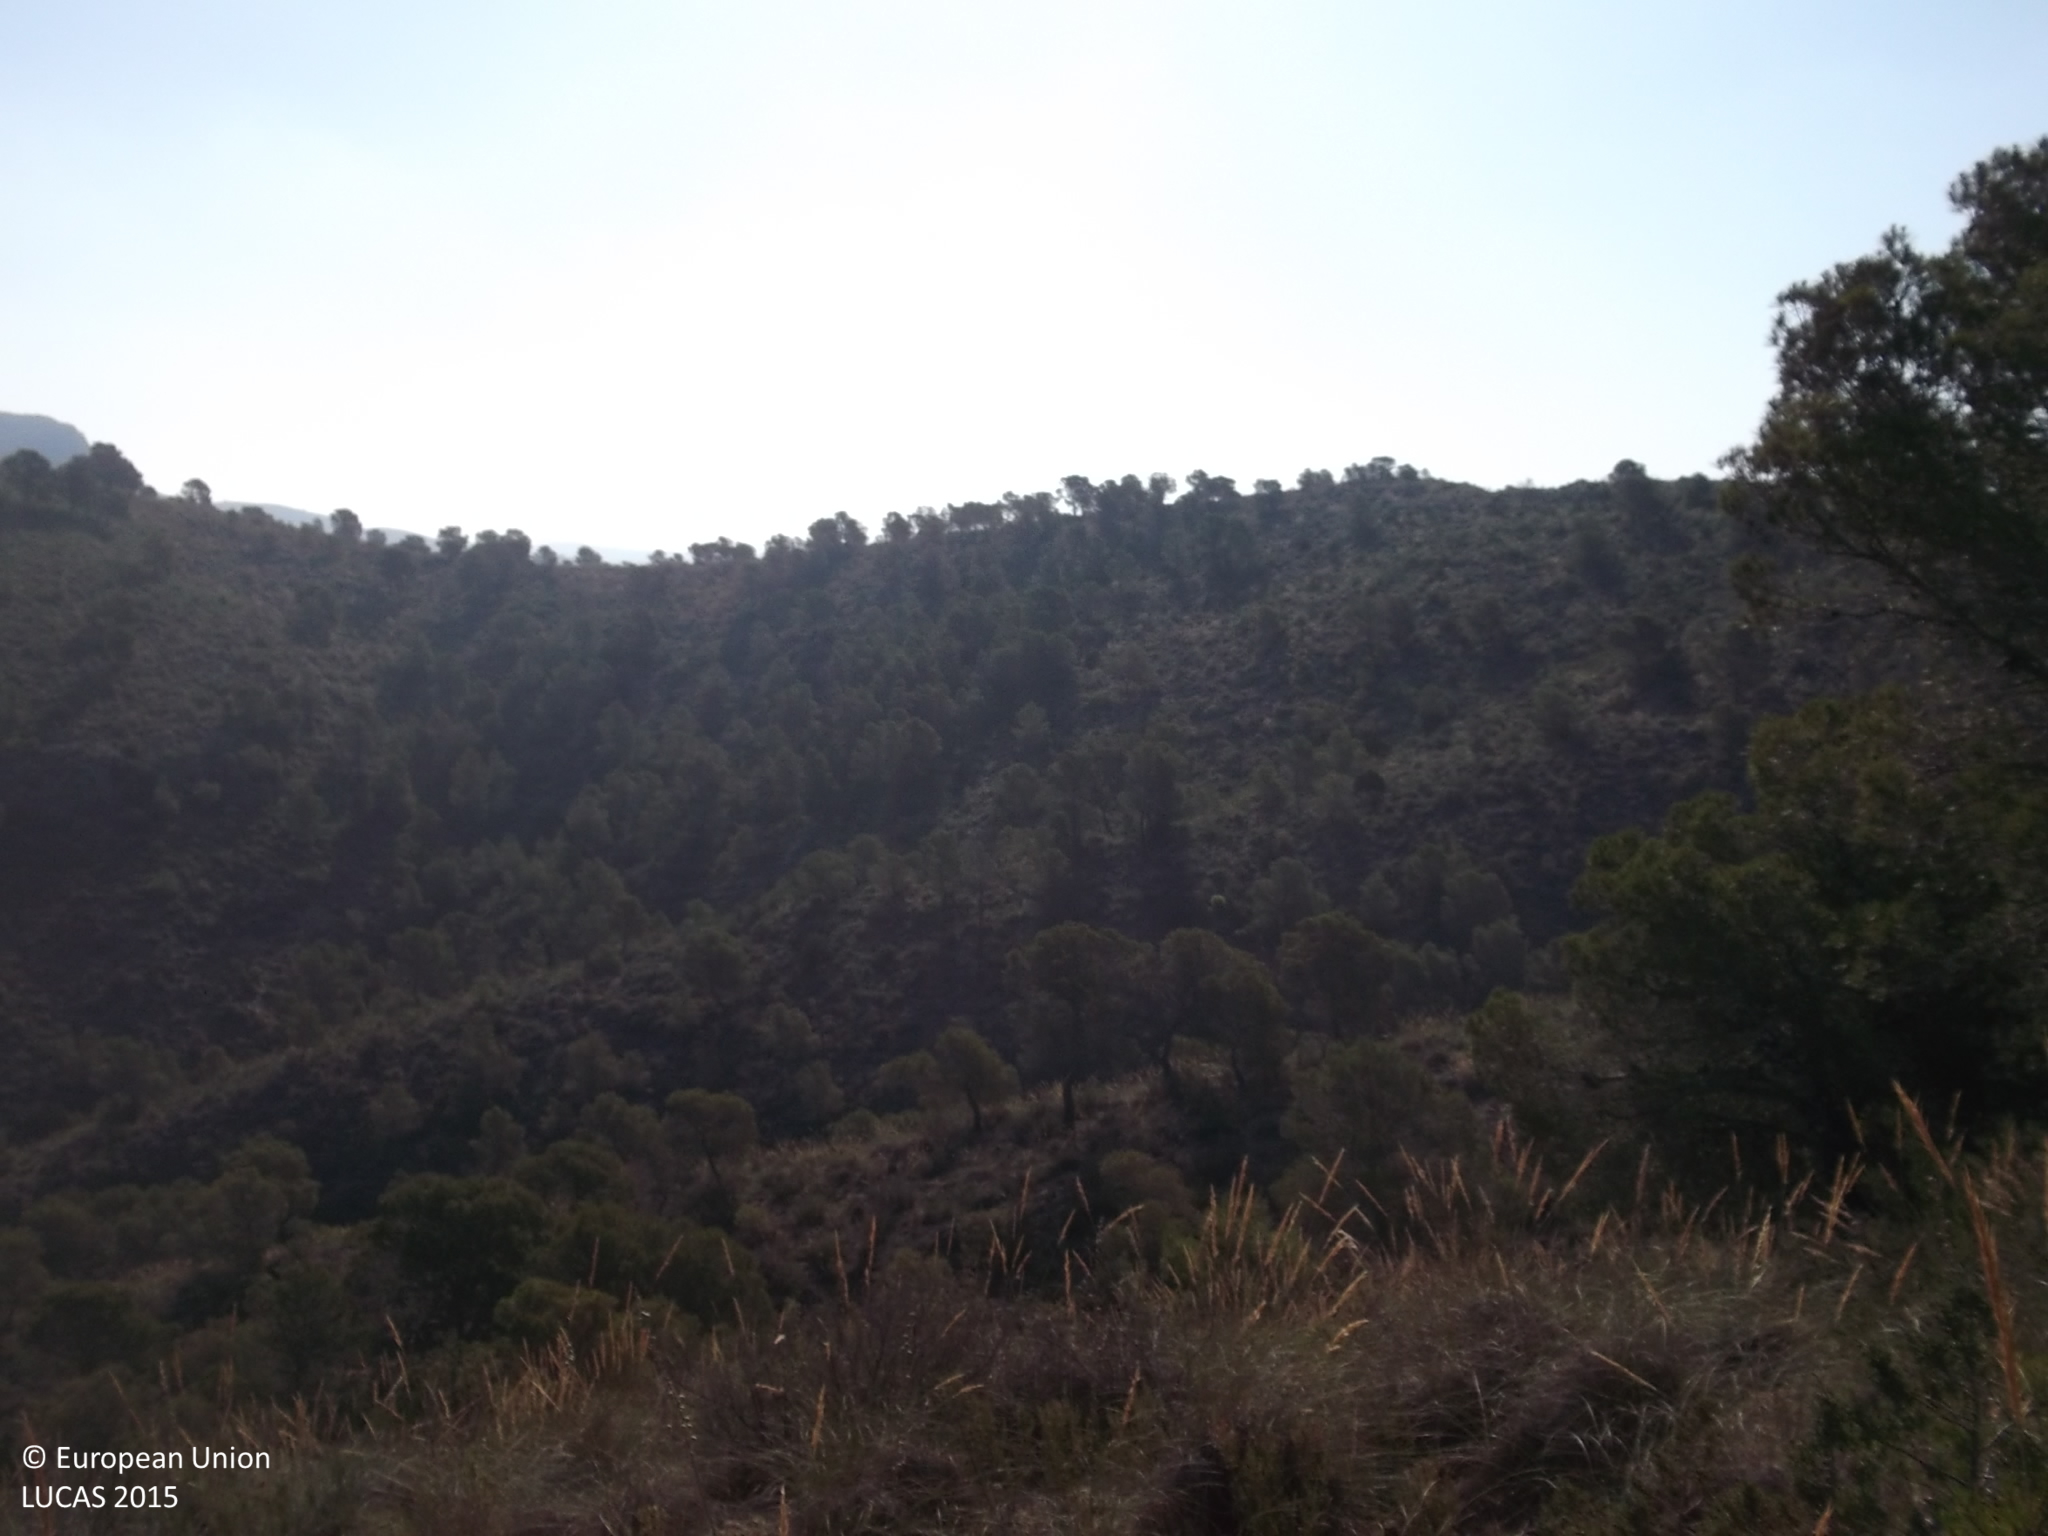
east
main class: Woodland
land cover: Pine dominated coniferous woodland
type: coniferous forest of the mediterranean region
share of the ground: 10 - 25 %
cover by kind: shrubs 40 %, coniferous forest trees 20 %, herbaceous plants 20 %, consolidated bare surface 20 %
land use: Semi-natural and natural areas not in use
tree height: > 5 m
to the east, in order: Pine dominated coniferous woodland
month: May
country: ES
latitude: 38.4261
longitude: -1.5953
